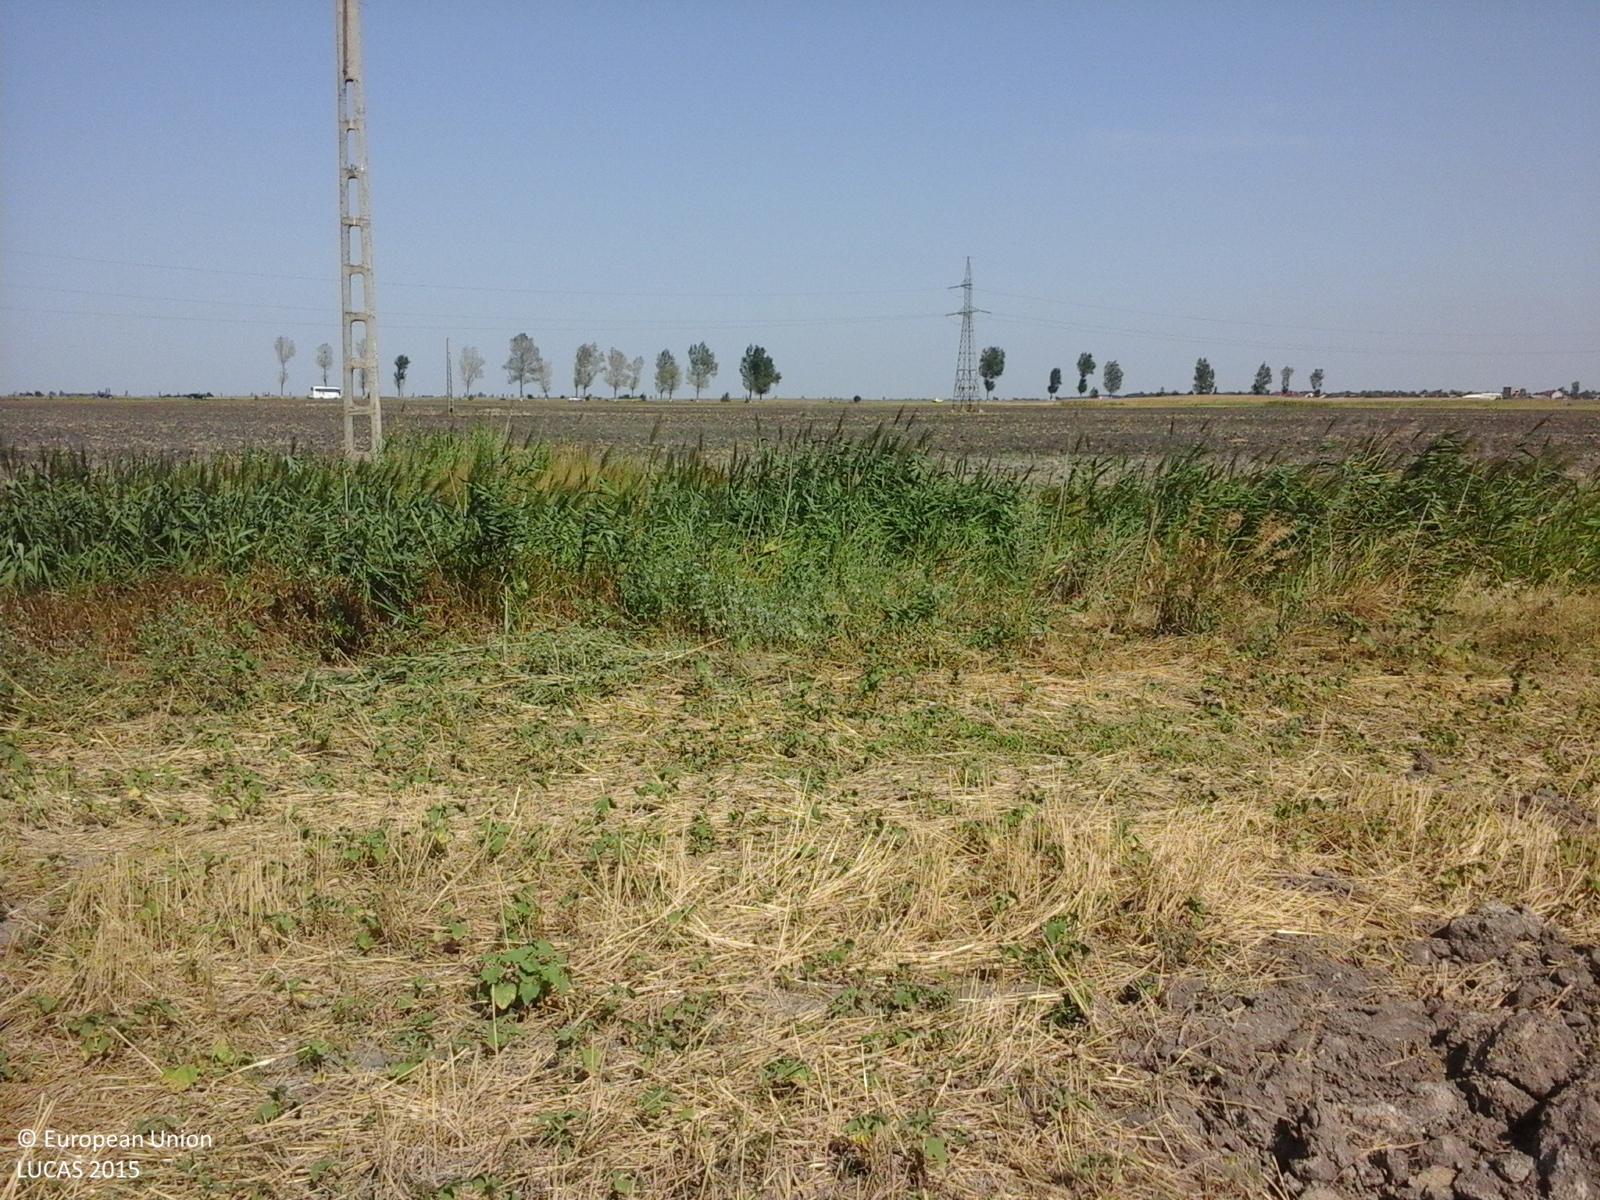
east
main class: Cropland
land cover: Common wheat
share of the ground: < 10 %
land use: Agriculture (excluding fallow land and kitchen gardens)
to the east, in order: Common wheat; Other bare soil; Electric lines; Other bare soil; Grass margins; Ditches and canals; Grass margins; Common wheat
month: August
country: RO
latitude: 45.0955
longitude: 26.8404
